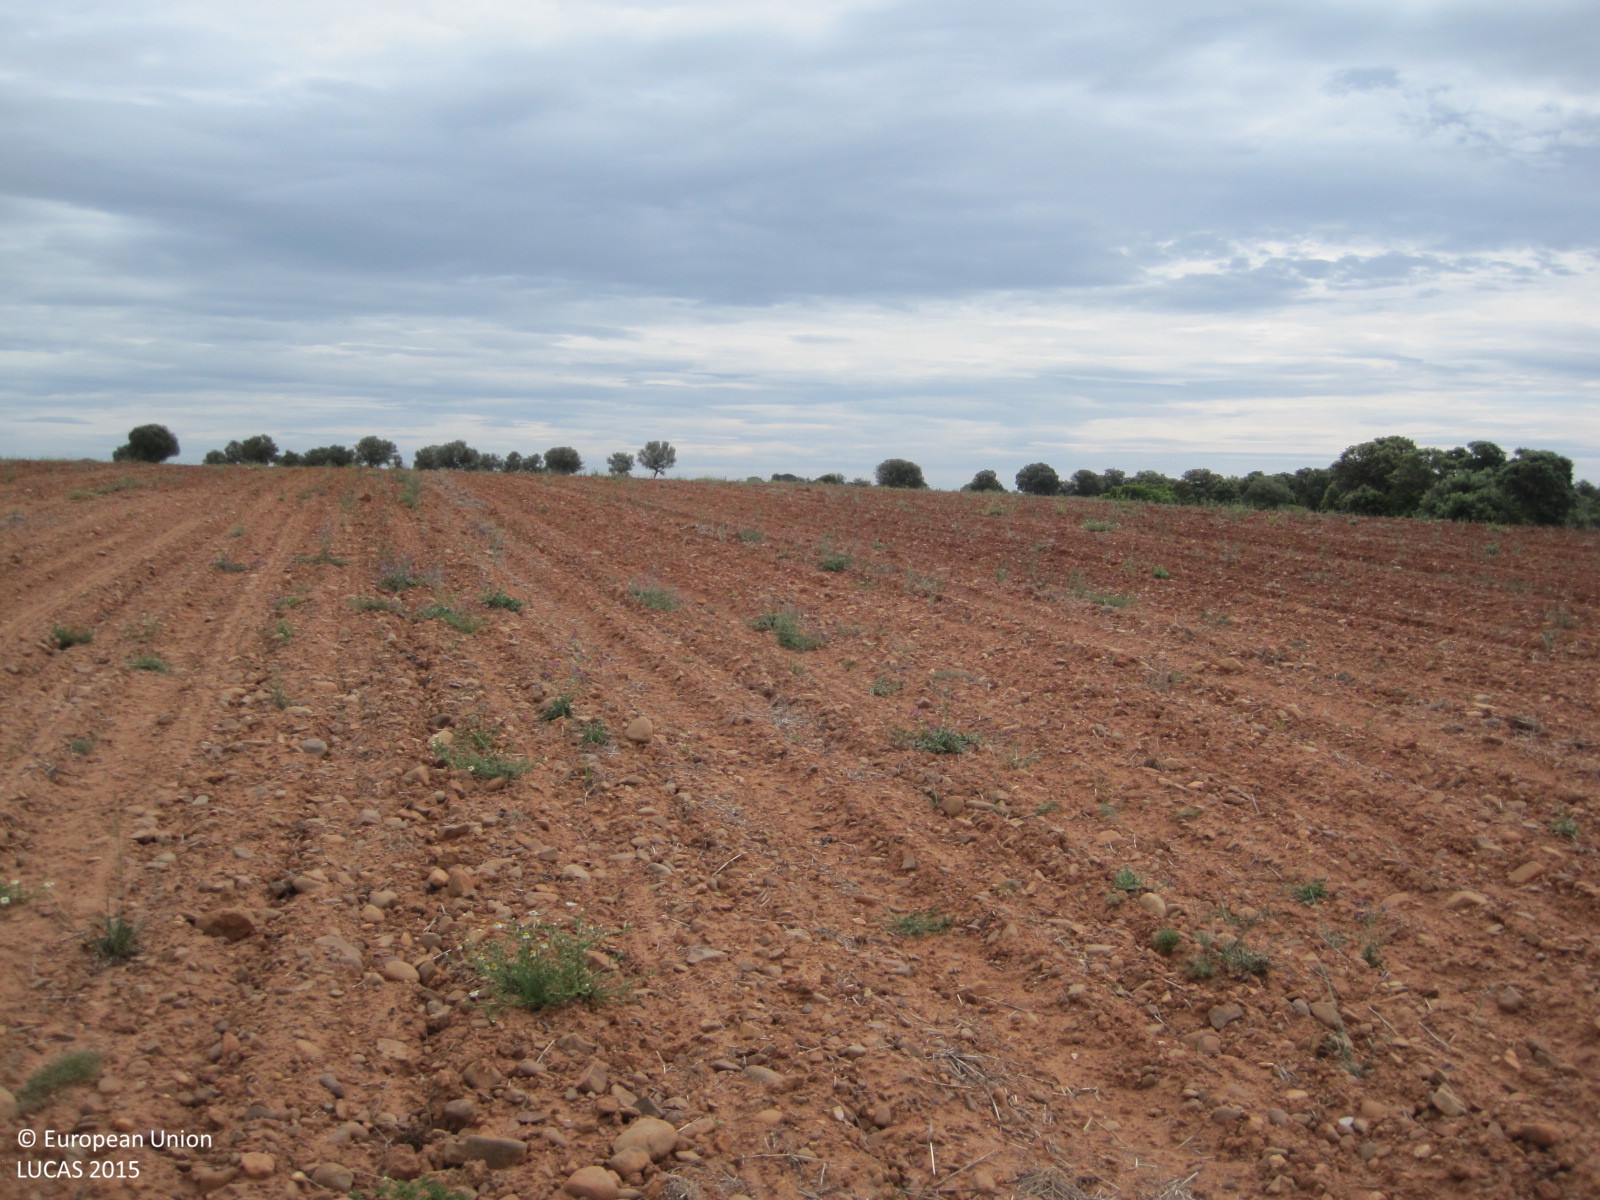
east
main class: Cropland
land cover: Sunflower
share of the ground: < 10 %
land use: Agriculture (excluding fallow land and kitchen gardens)
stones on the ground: 25 - 50 %
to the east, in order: Sunflower
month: May
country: ES
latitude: 39.9164
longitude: -4.7515
